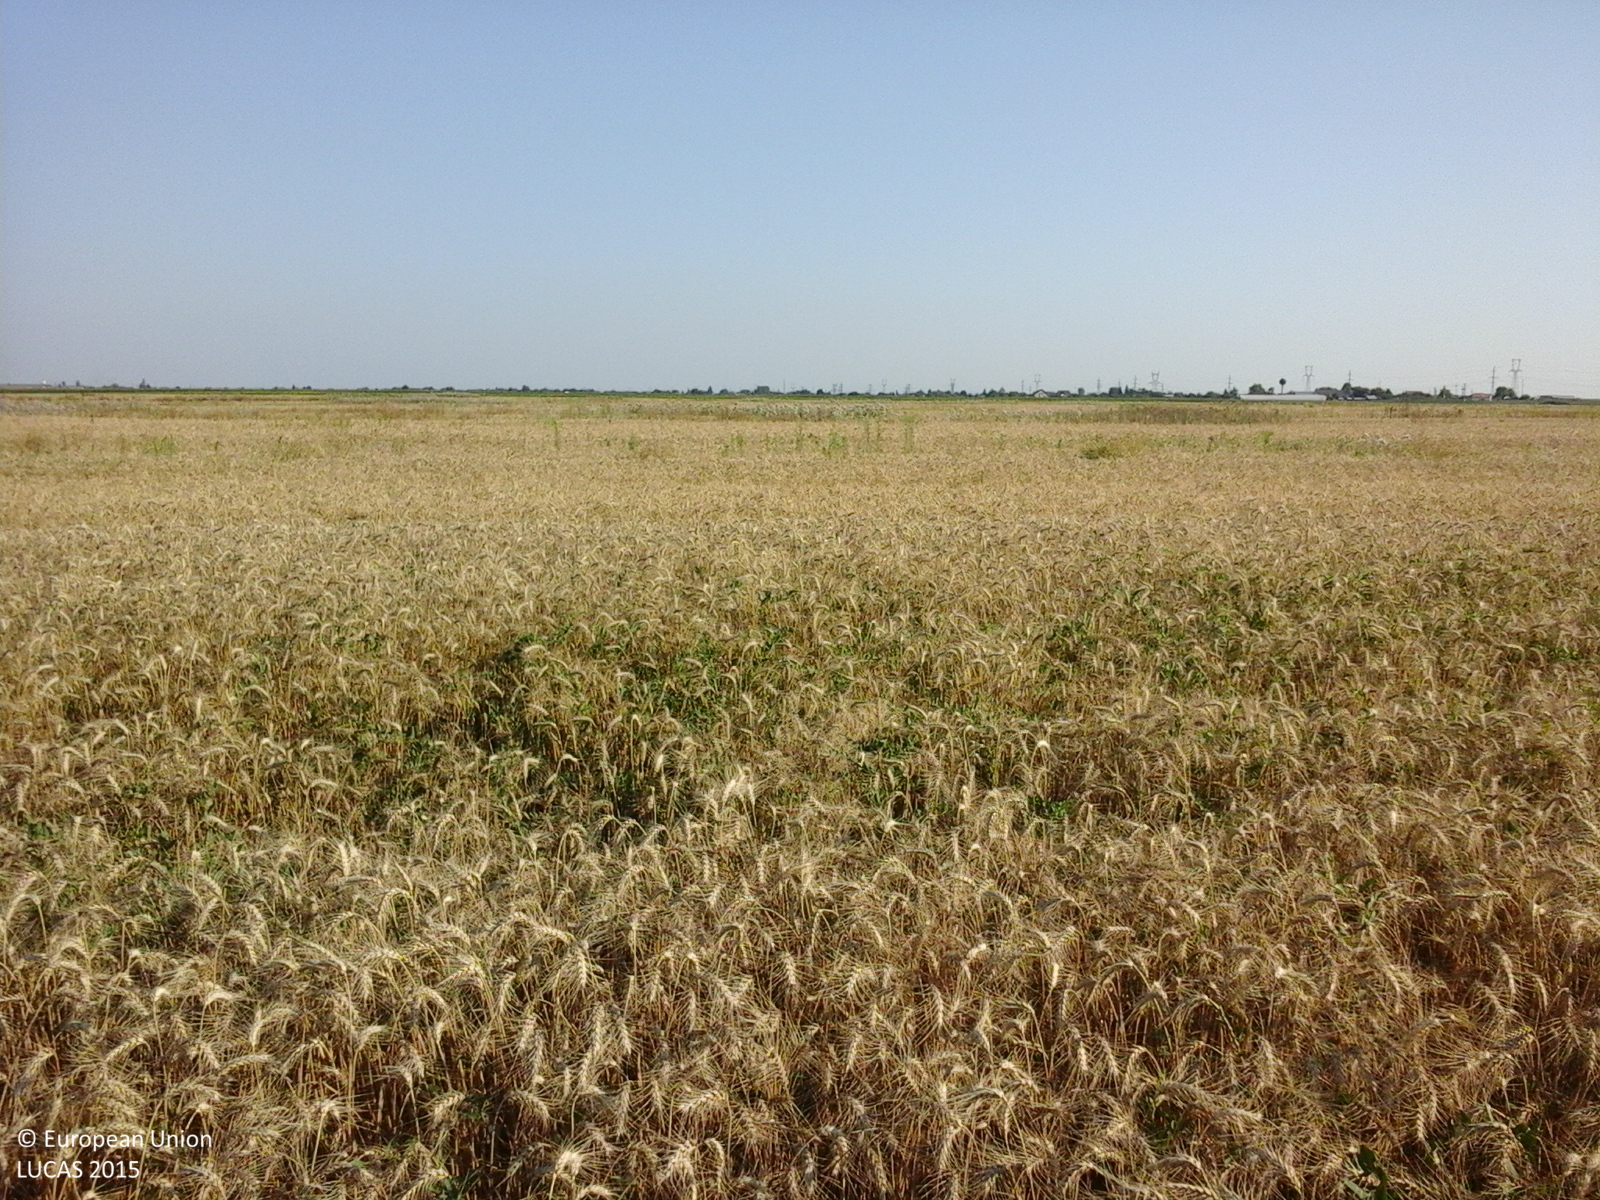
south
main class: Cropland
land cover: Common wheat
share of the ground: > 75 %
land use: Agriculture (excluding fallow land and kitchen gardens)
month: July
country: RO
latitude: 44.3210
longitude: 24.4504
